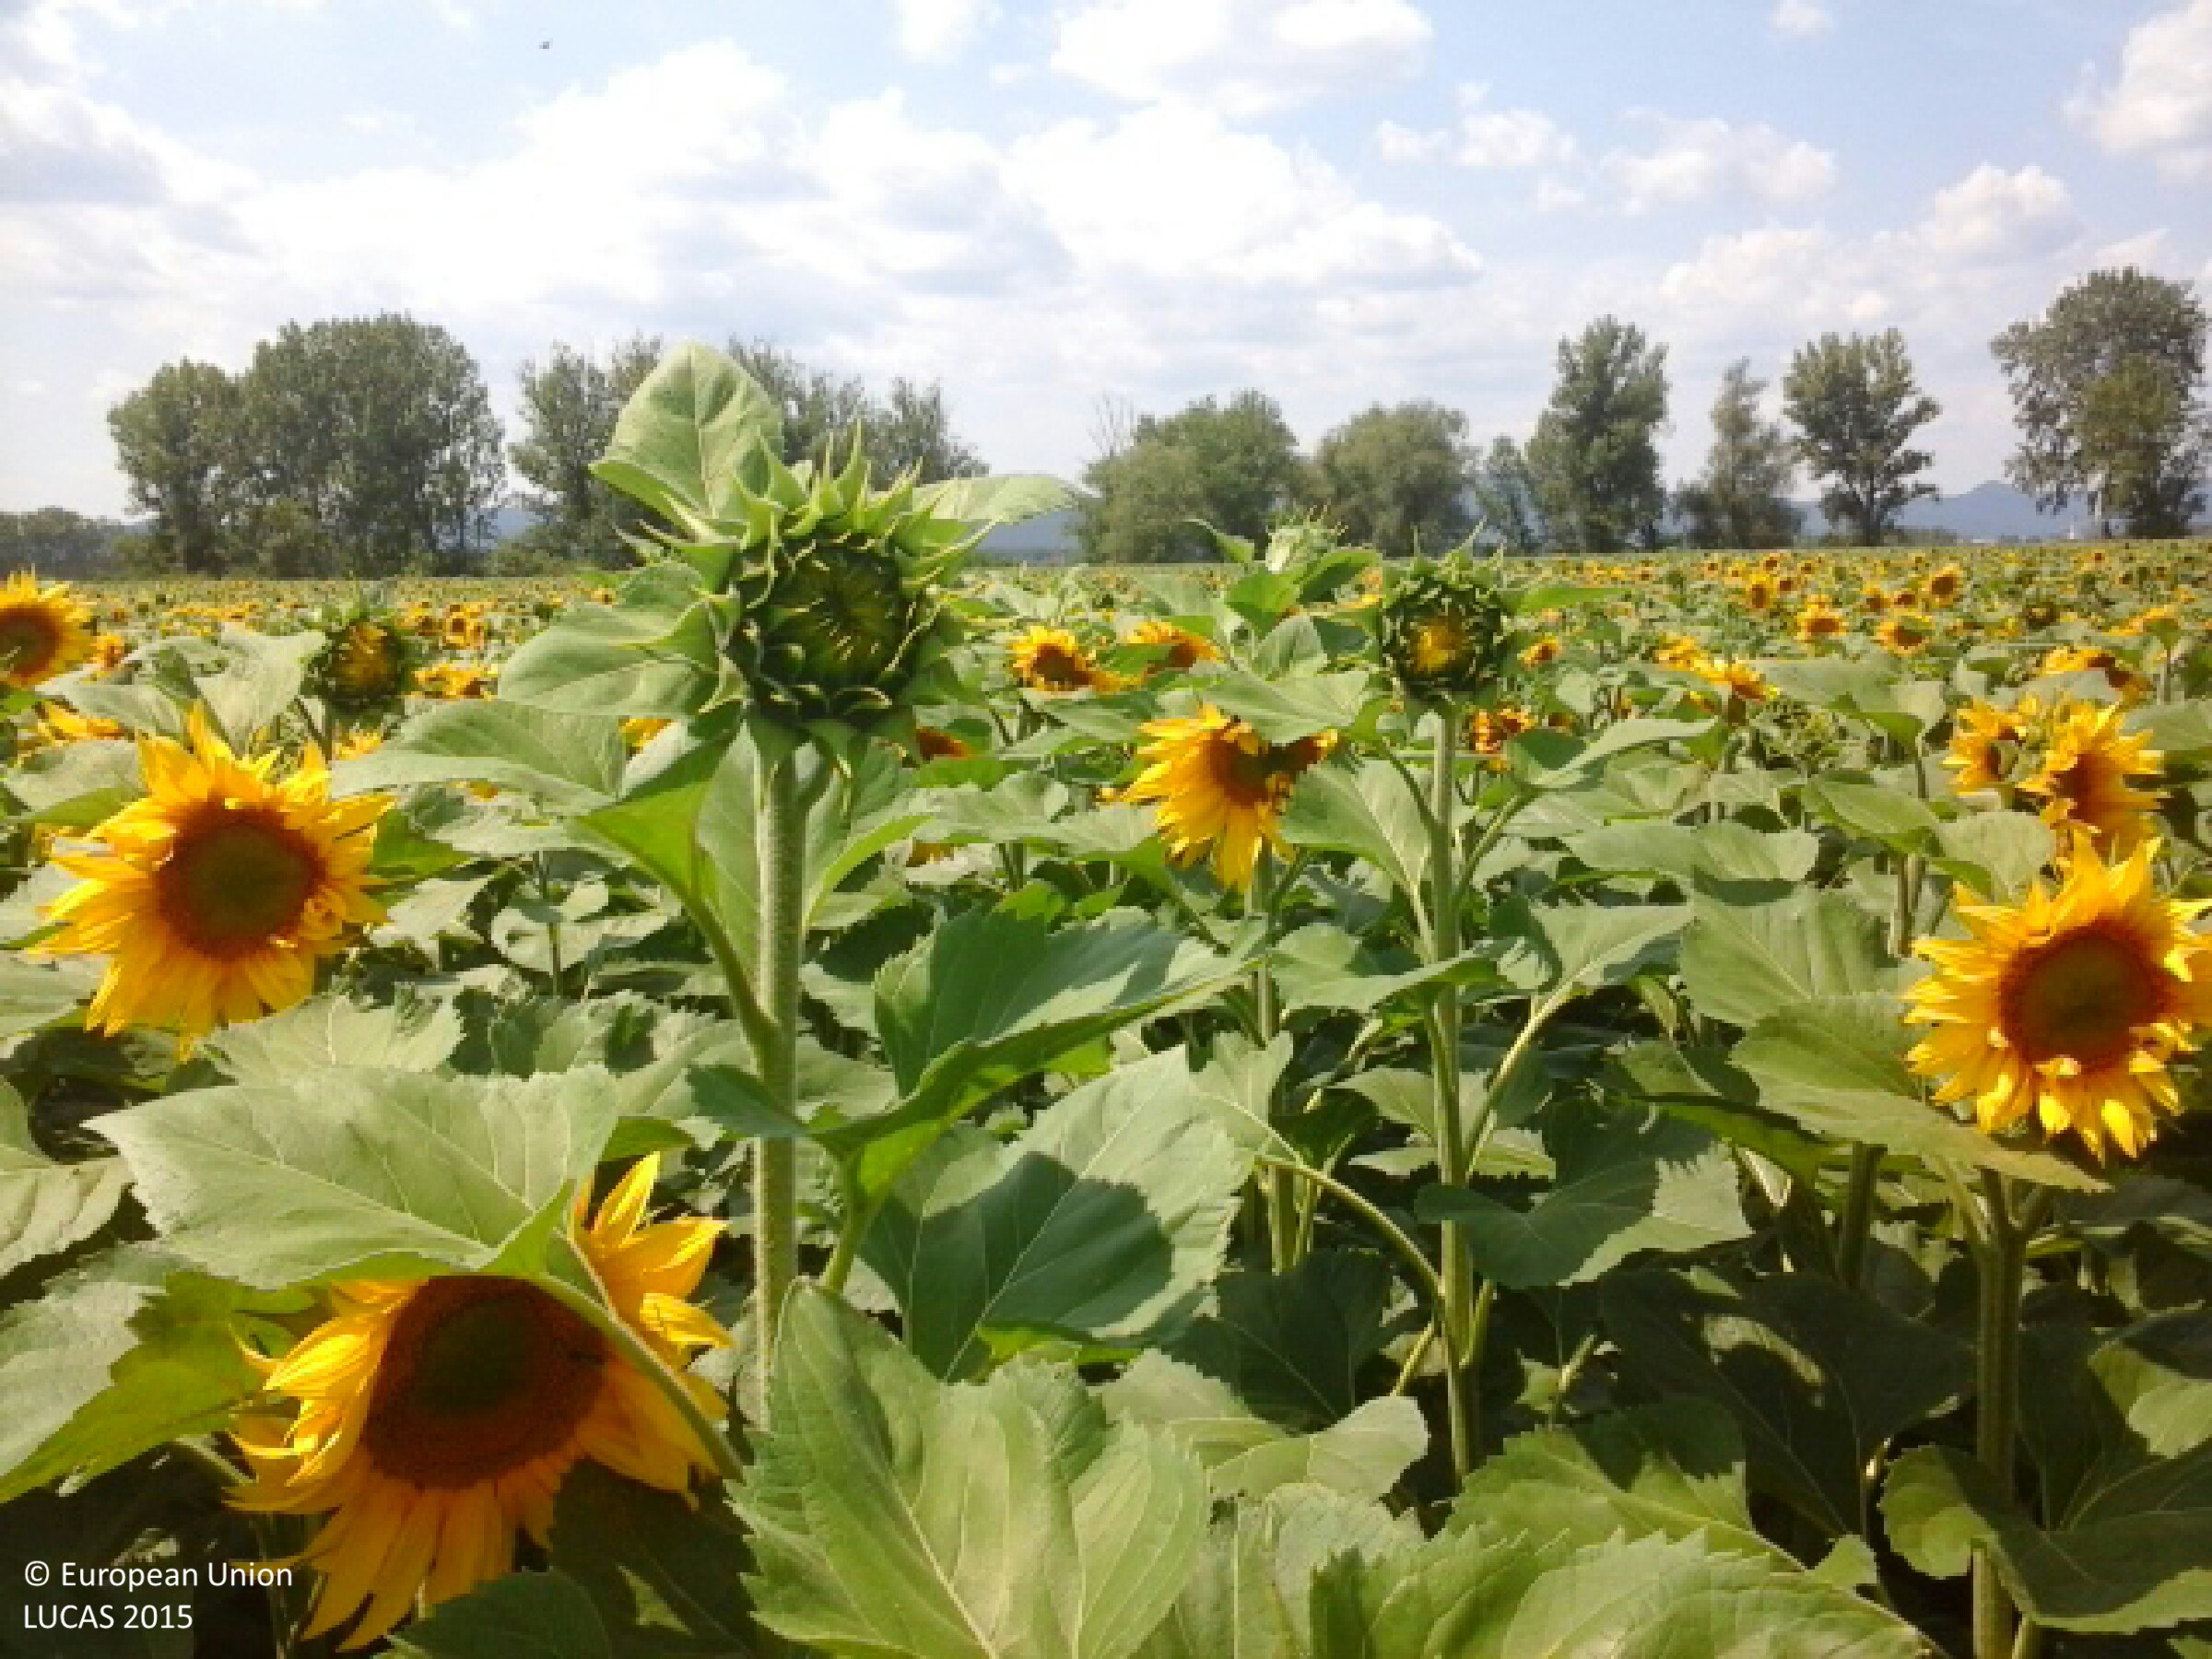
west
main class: Cropland
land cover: Sunflower
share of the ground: > 75 %
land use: Agriculture (excluding fallow land and kitchen gardens)
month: July
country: HU
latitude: 48.2995
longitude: 21.6006
